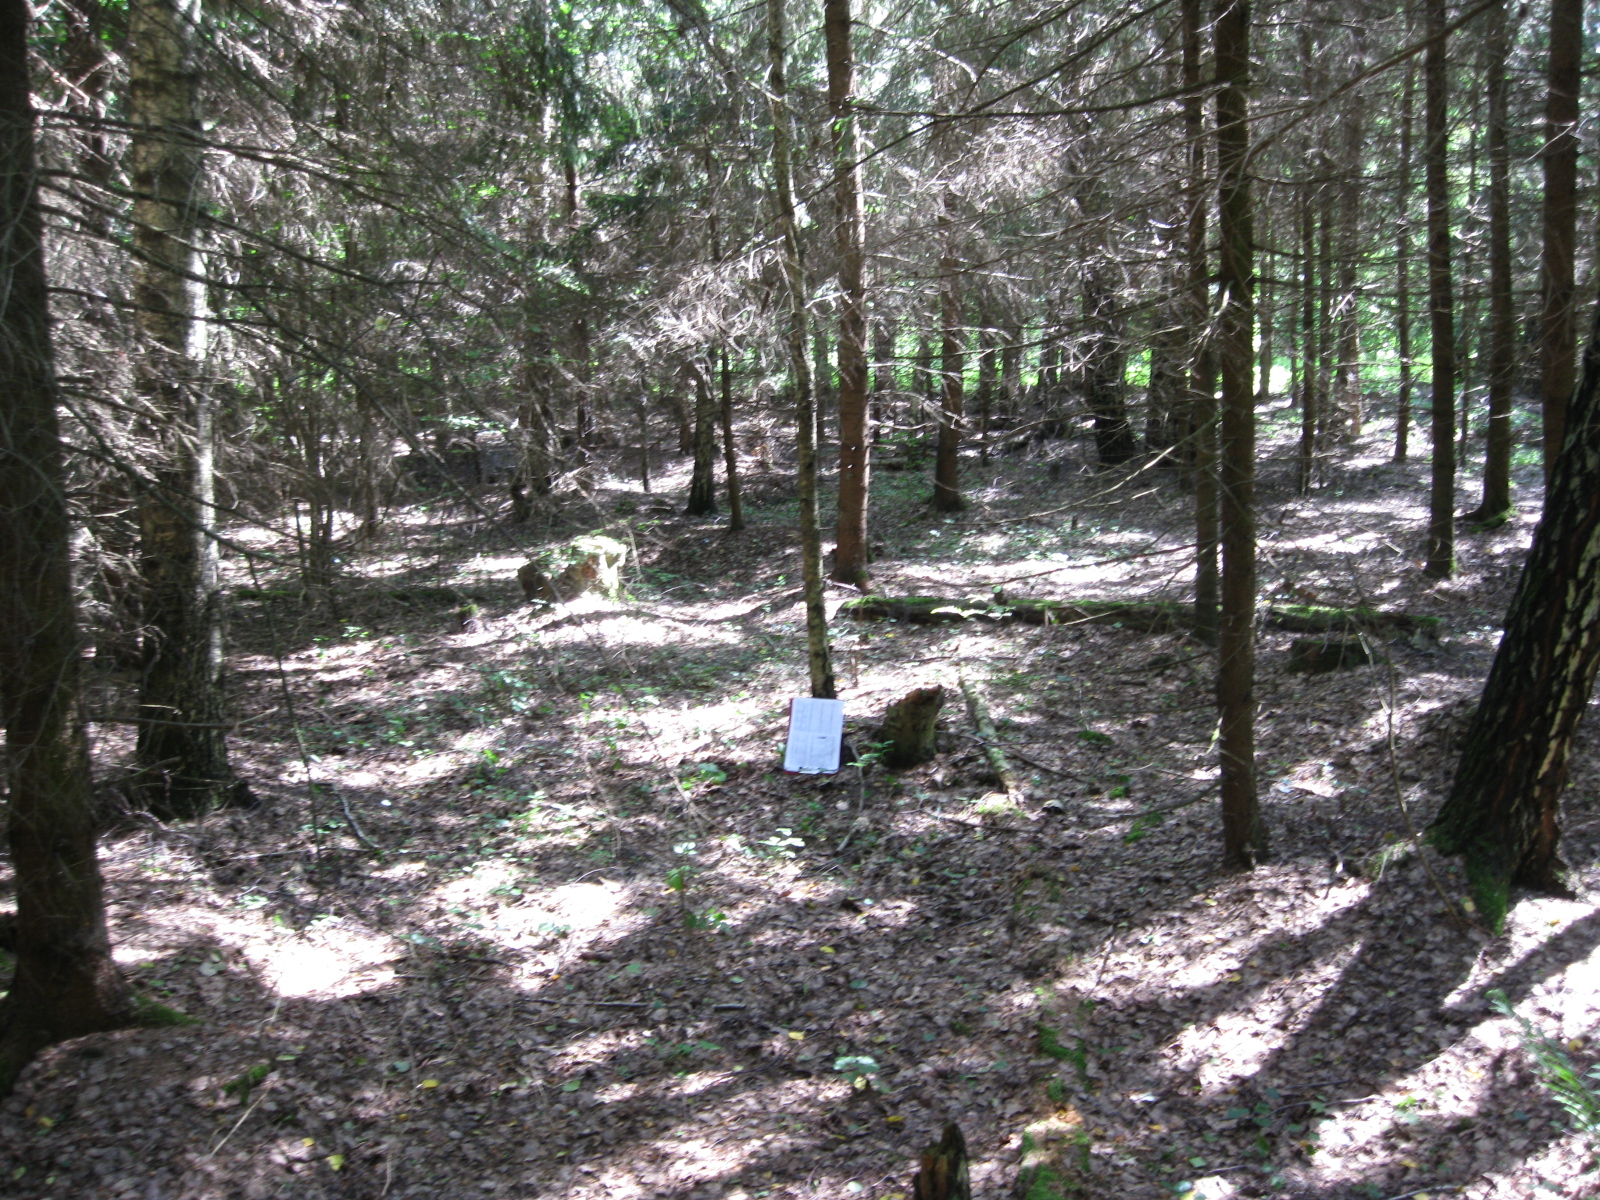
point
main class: Woodland
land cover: Spruce dominated mixed woodland
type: hemiboreal forest and nemoral coniferous forest and mixed broadleaved-coniferous forest
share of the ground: > 75 %
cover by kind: coniferous forest trees 70 %, broadleaved forest trees 30 %
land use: Forestry
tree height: > 5 m
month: June
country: LT
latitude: 55.1326
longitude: 23.7466
